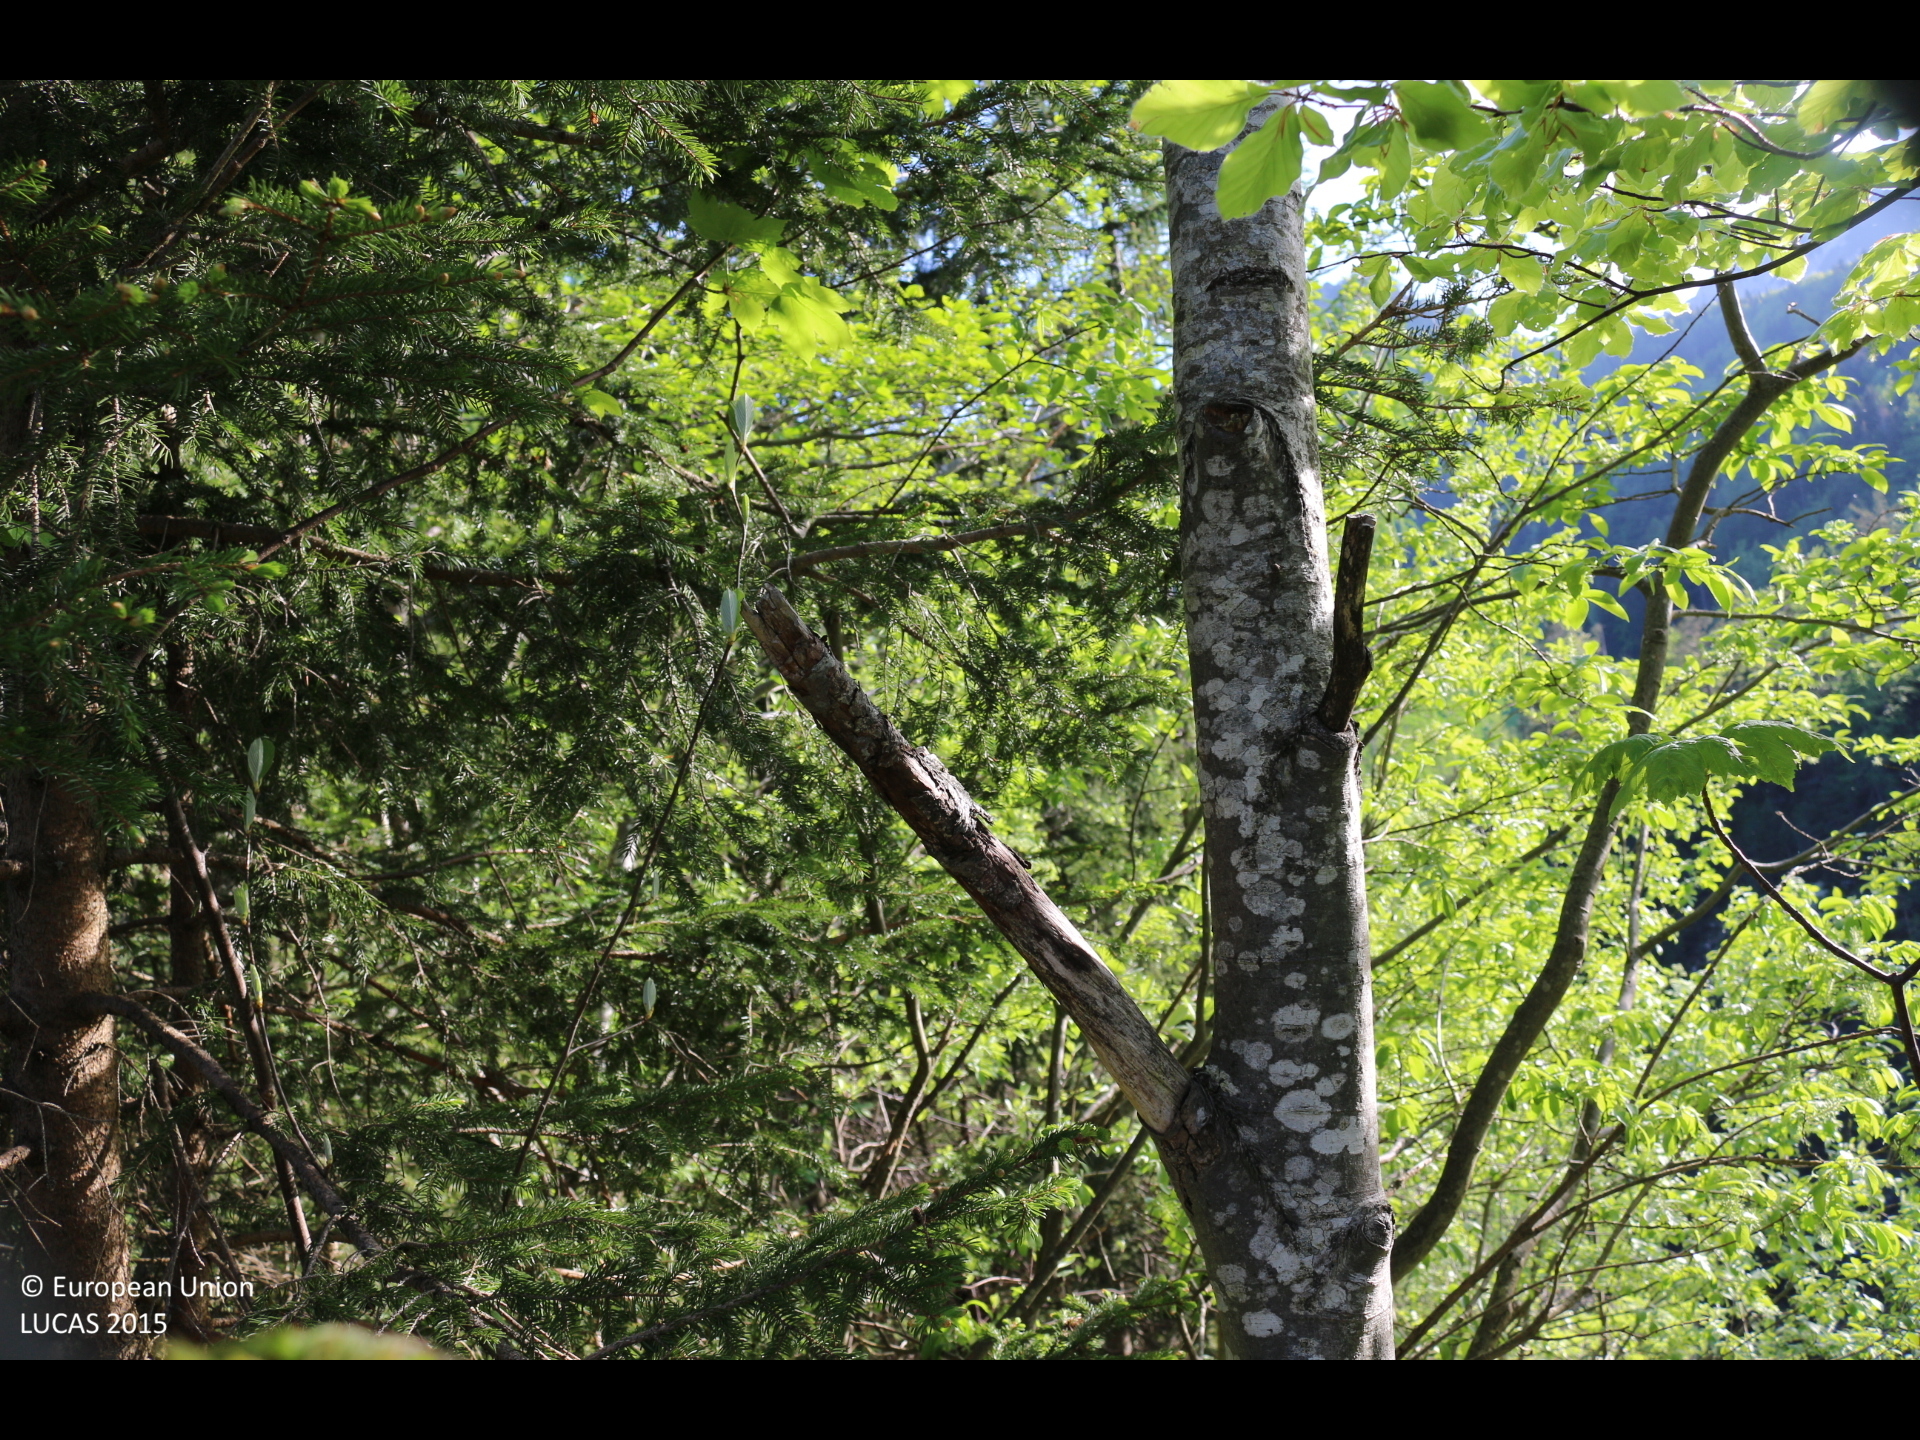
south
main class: Woodland
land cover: Spruce dominated mixed woodland
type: alpine coniferous forest
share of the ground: > 75 %
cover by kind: coniferous forest trees 60 %, broadleaved forest trees 40 %
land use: Forestry
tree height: > 5 m
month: May
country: AT
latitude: 46.4470
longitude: 14.2539
